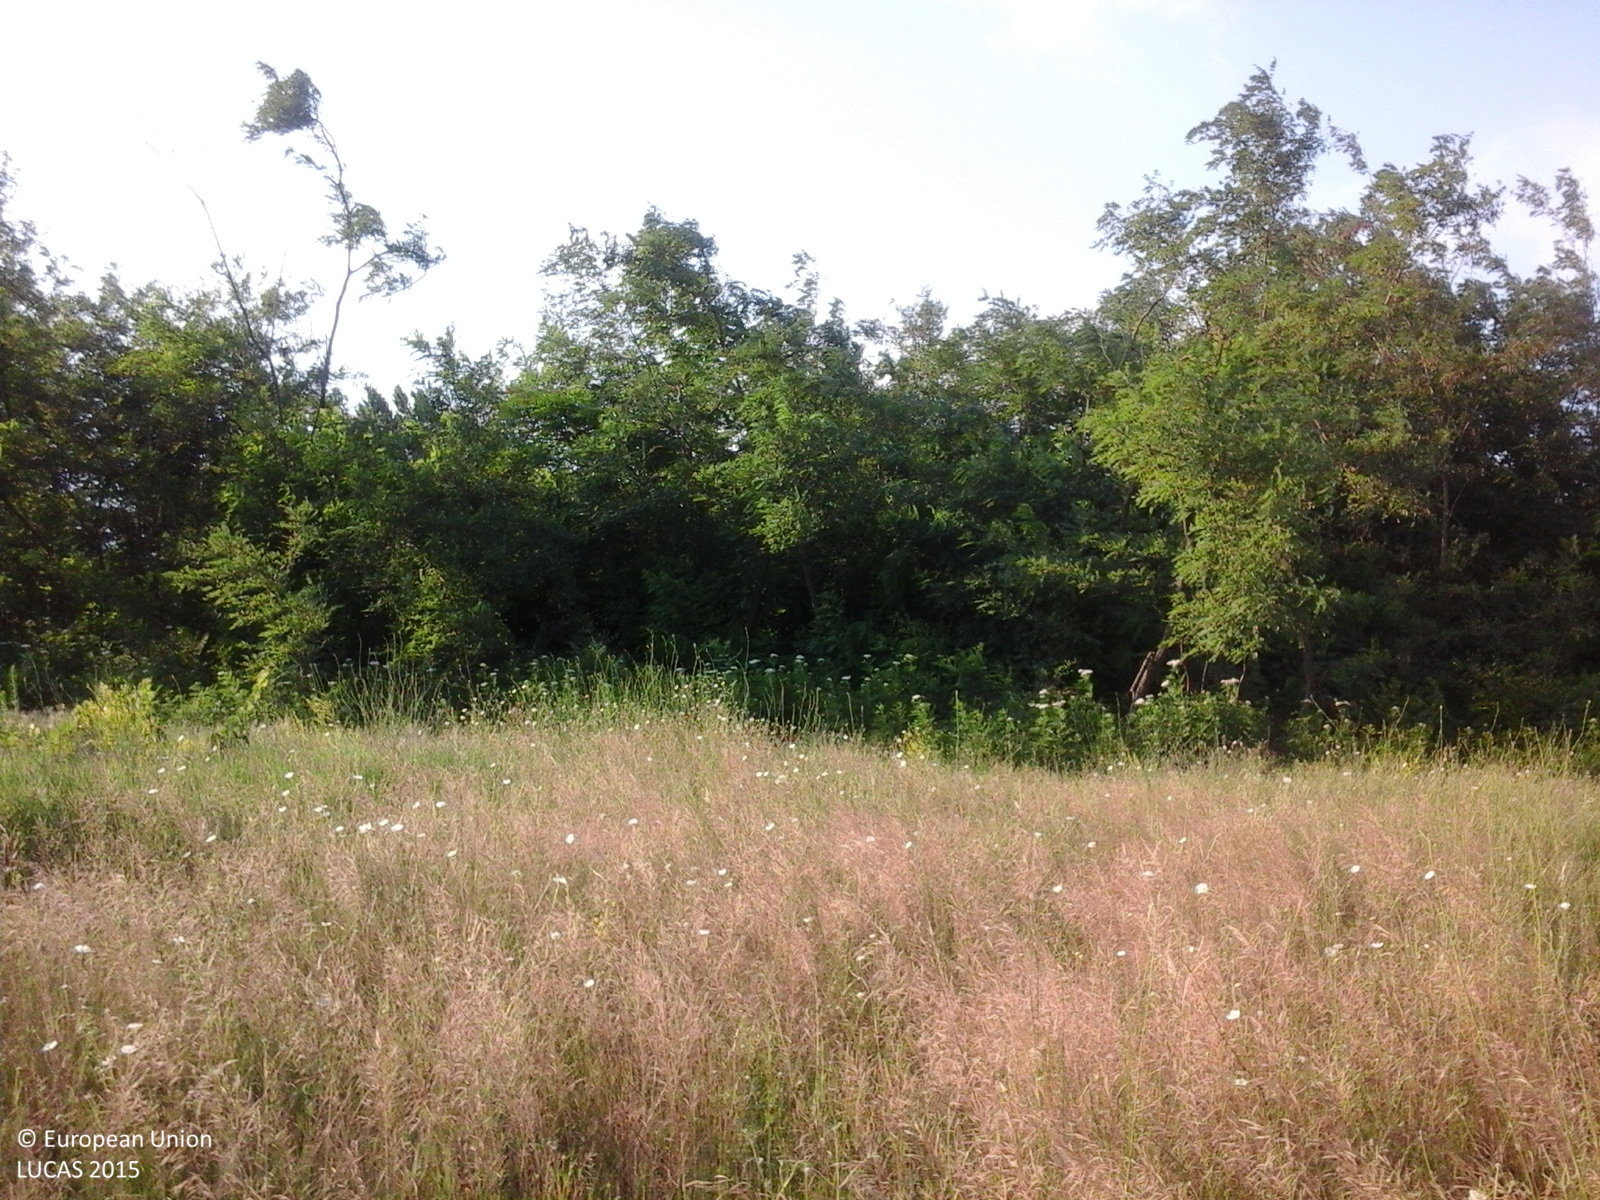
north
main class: Grassland
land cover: Grassland without tree/shrub cover
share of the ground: > 75 %
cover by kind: herbaceous plants 100 %
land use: Agriculture (excluding fallow land and kitchen gardens)
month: July
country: RO
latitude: 43.7729
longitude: 24.1842
